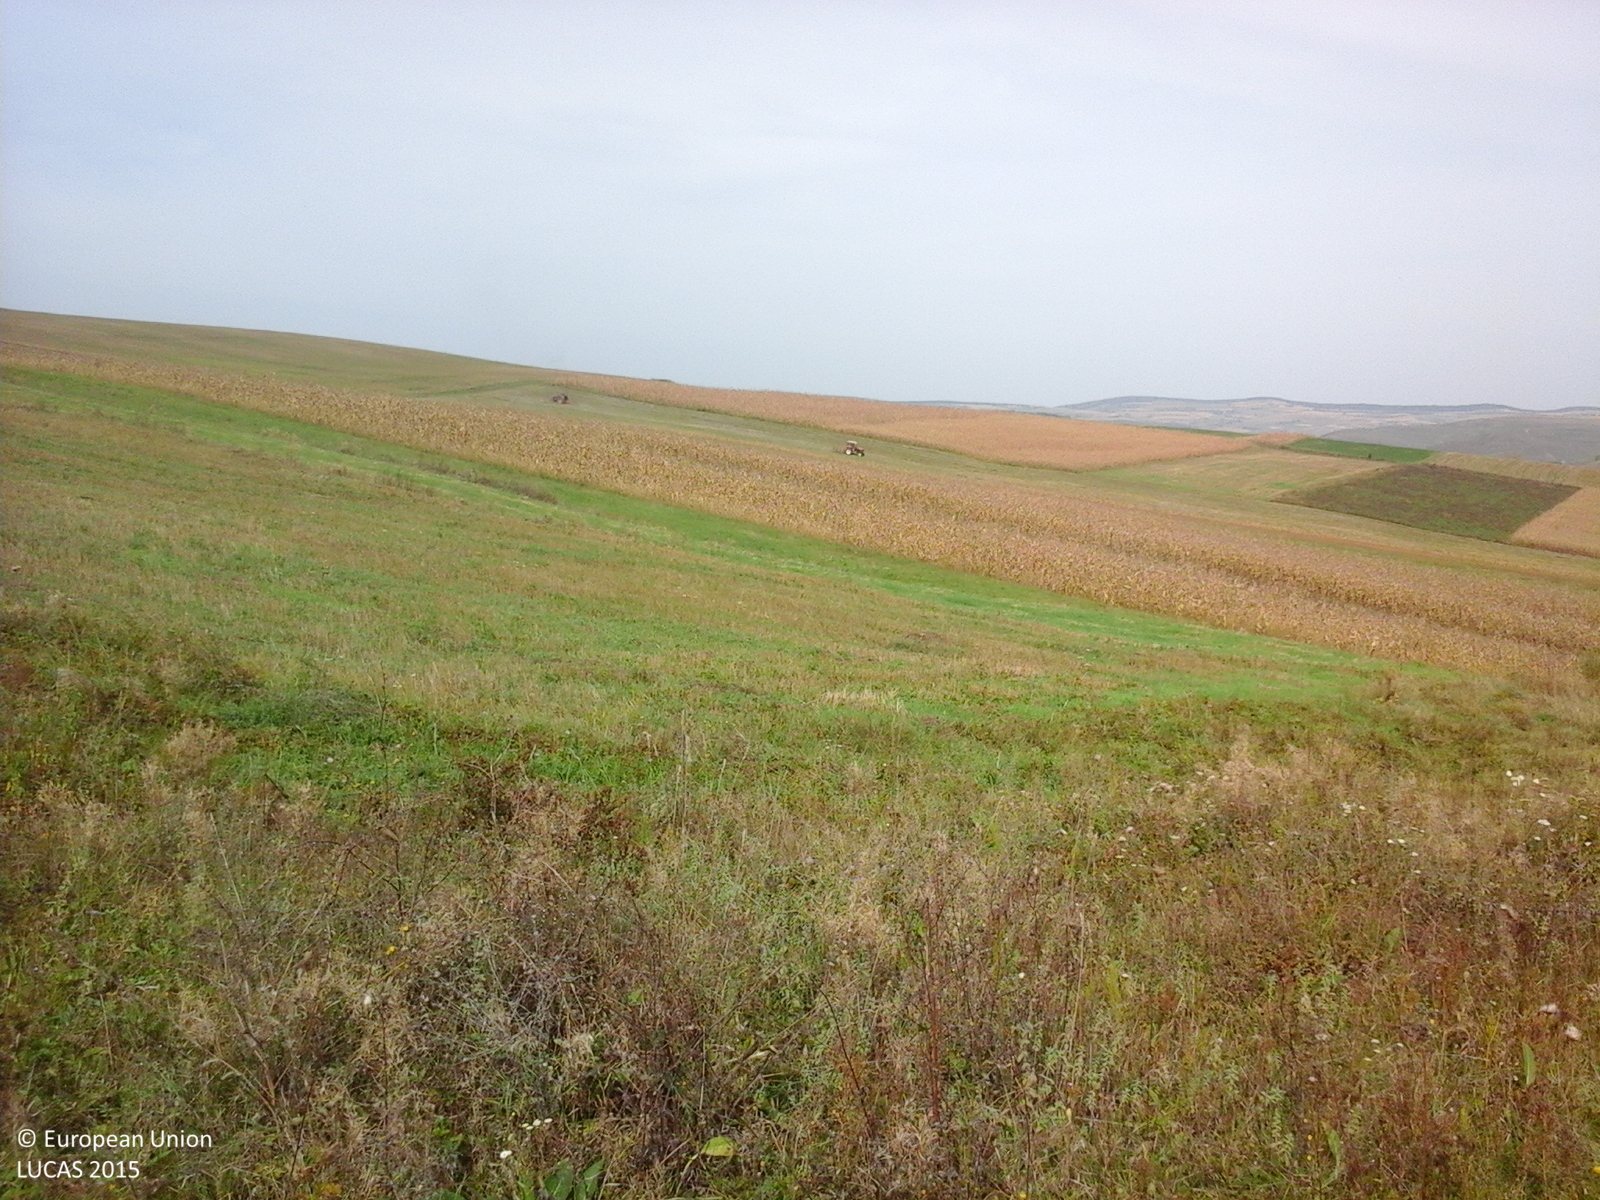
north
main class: Grassland
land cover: Spontaneously vegetated surfaces
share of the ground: > 75 %
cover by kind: herbaceous plants 100 %
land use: Fallow land
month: September
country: RO
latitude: 46.8336
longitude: 24.1229
